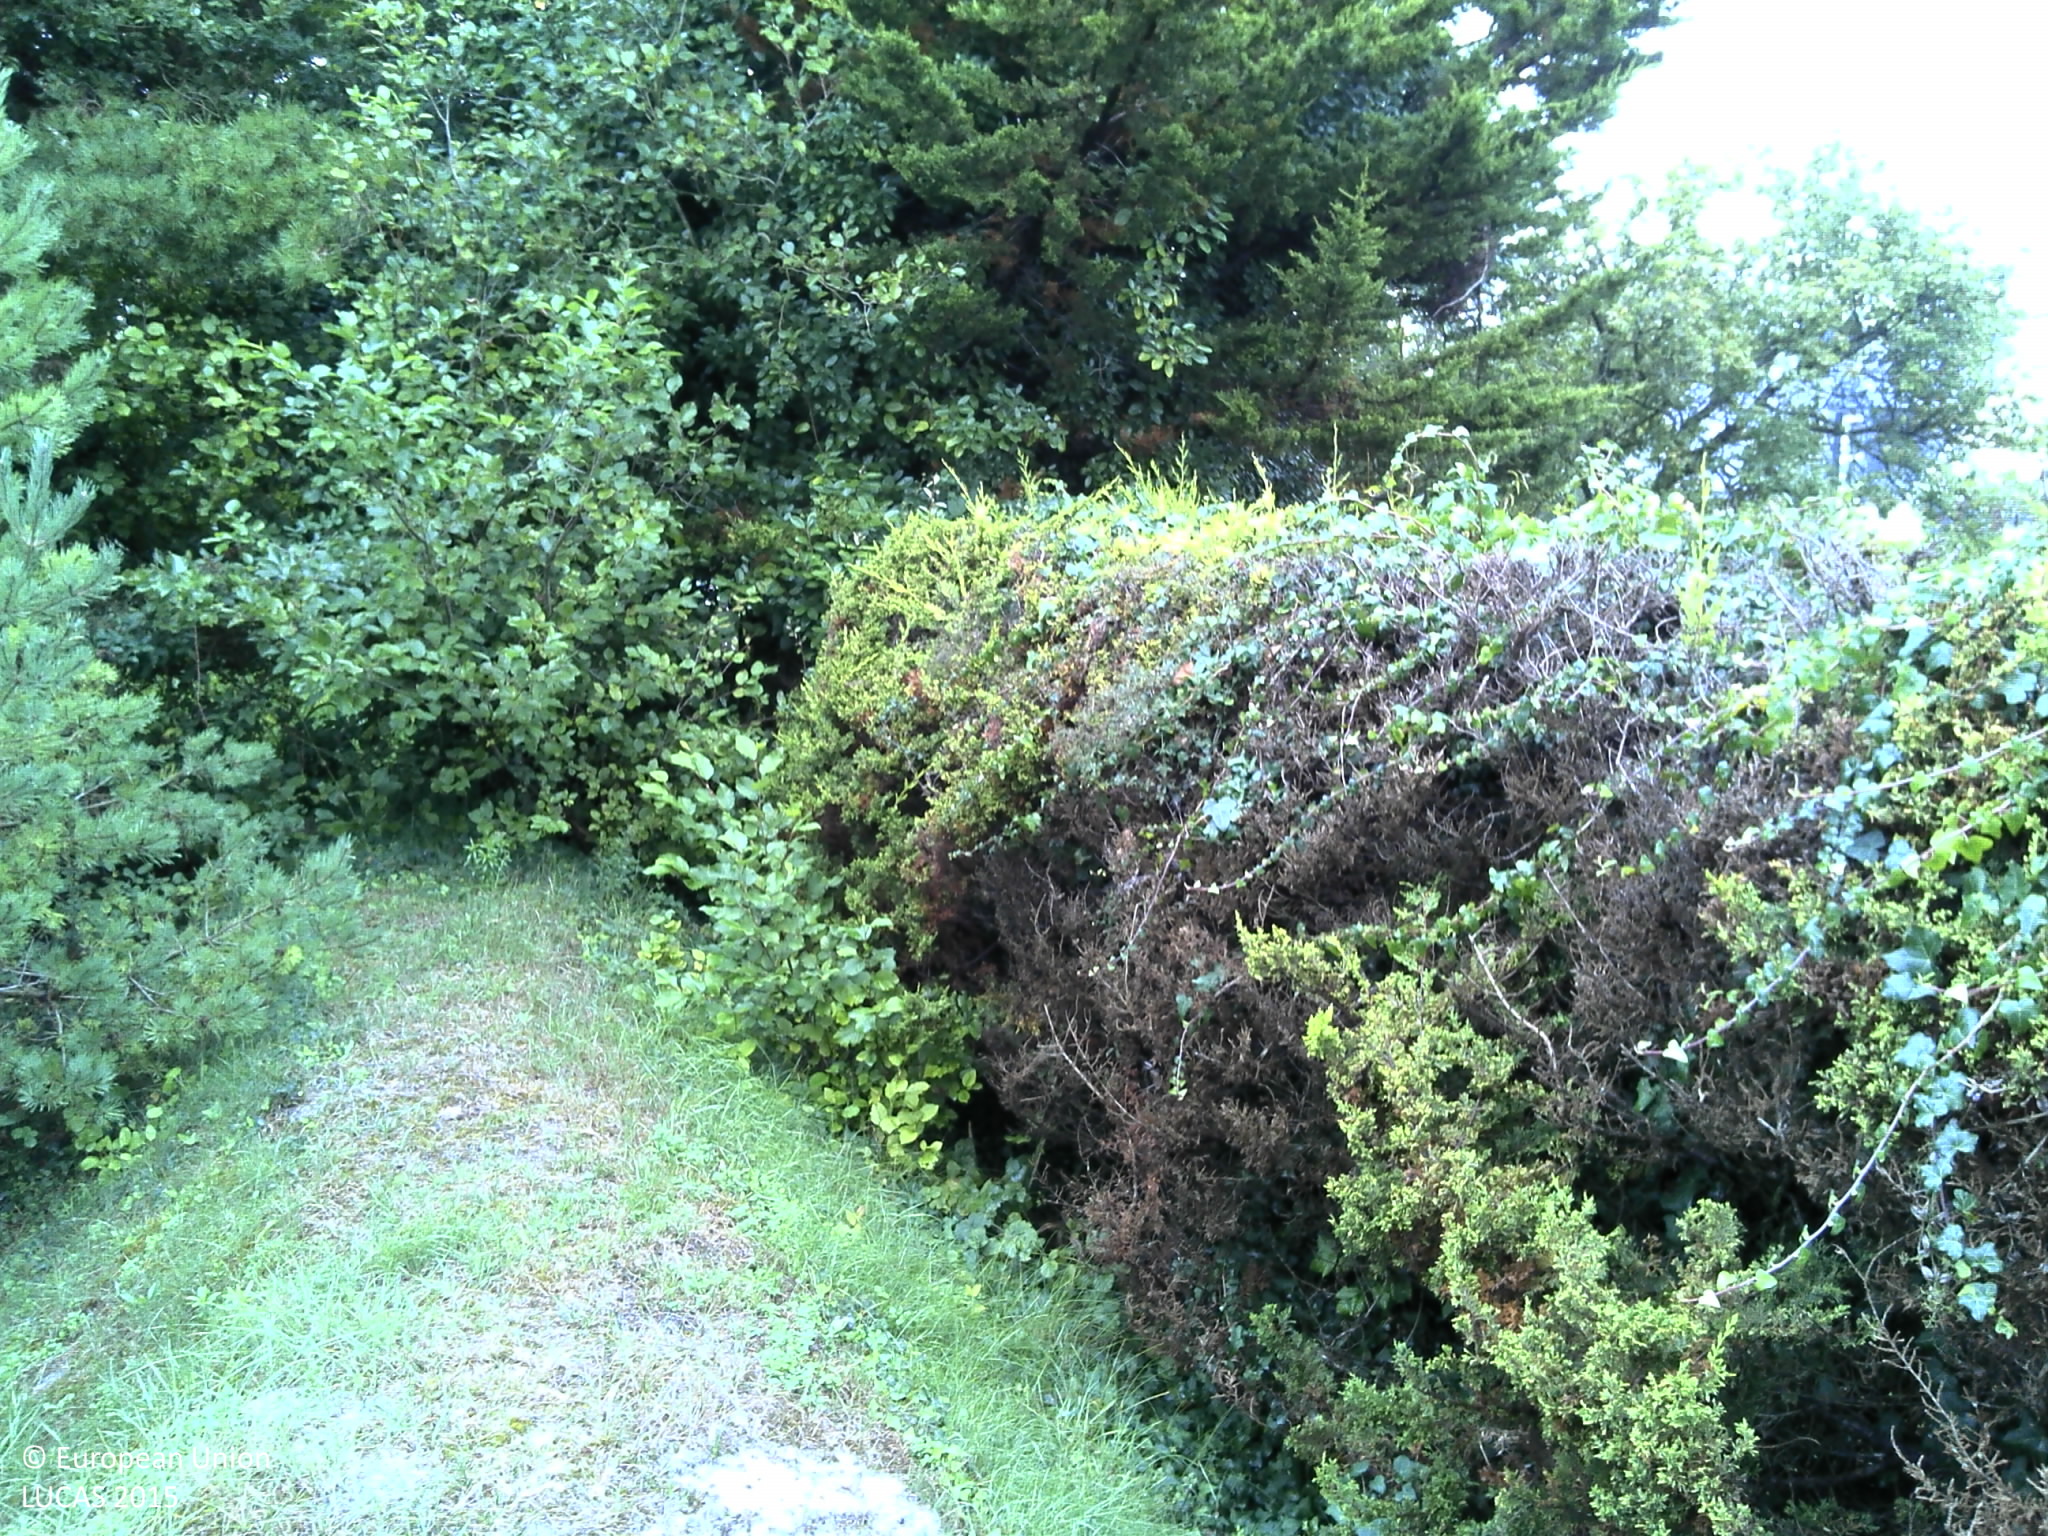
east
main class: Grassland
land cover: Grassland with sparse tree/shrub cover
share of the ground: > 75 %
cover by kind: herbaceous plants 95 %, broadleaved forest trees 5 %
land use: Residential
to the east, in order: Grassland with sparse tree/shrub cover; Artificial constructions in urban areas; Grass margins; Ditches and canals; Broadleaved woodland
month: August
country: FR
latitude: 48.6403
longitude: -4.2768
